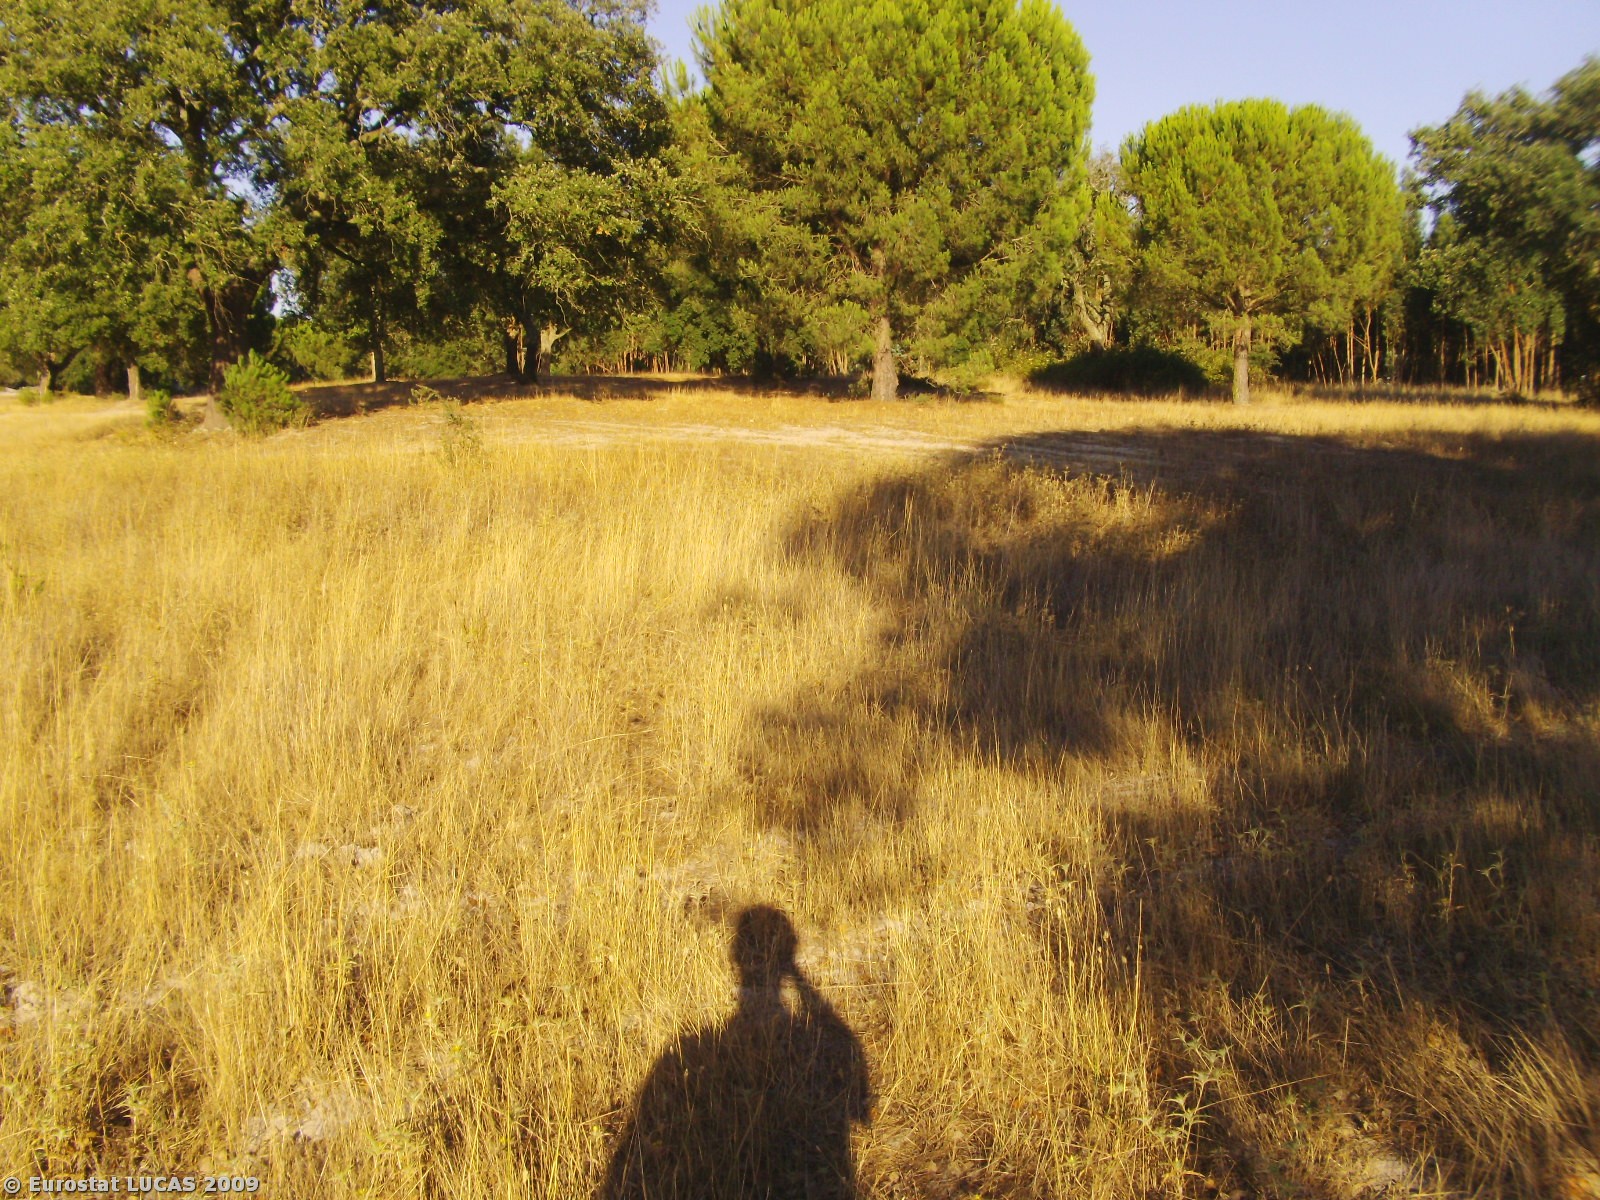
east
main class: Grassland
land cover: Grassland with sparse tree/shrub cover
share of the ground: 10 - 25 %
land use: Forestry
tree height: > 5 m
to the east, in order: Grassland with sparse tree/shrub cover; Coniferous woodland; Spontaneously vegetated surfaces; Tracks; Spontaneously vegetated surfaces; Bare land; Broadleaved woodland; Bare land; Grassland with sparse tree/shrub cover
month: July
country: PT
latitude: 38.7489
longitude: -8.7862
